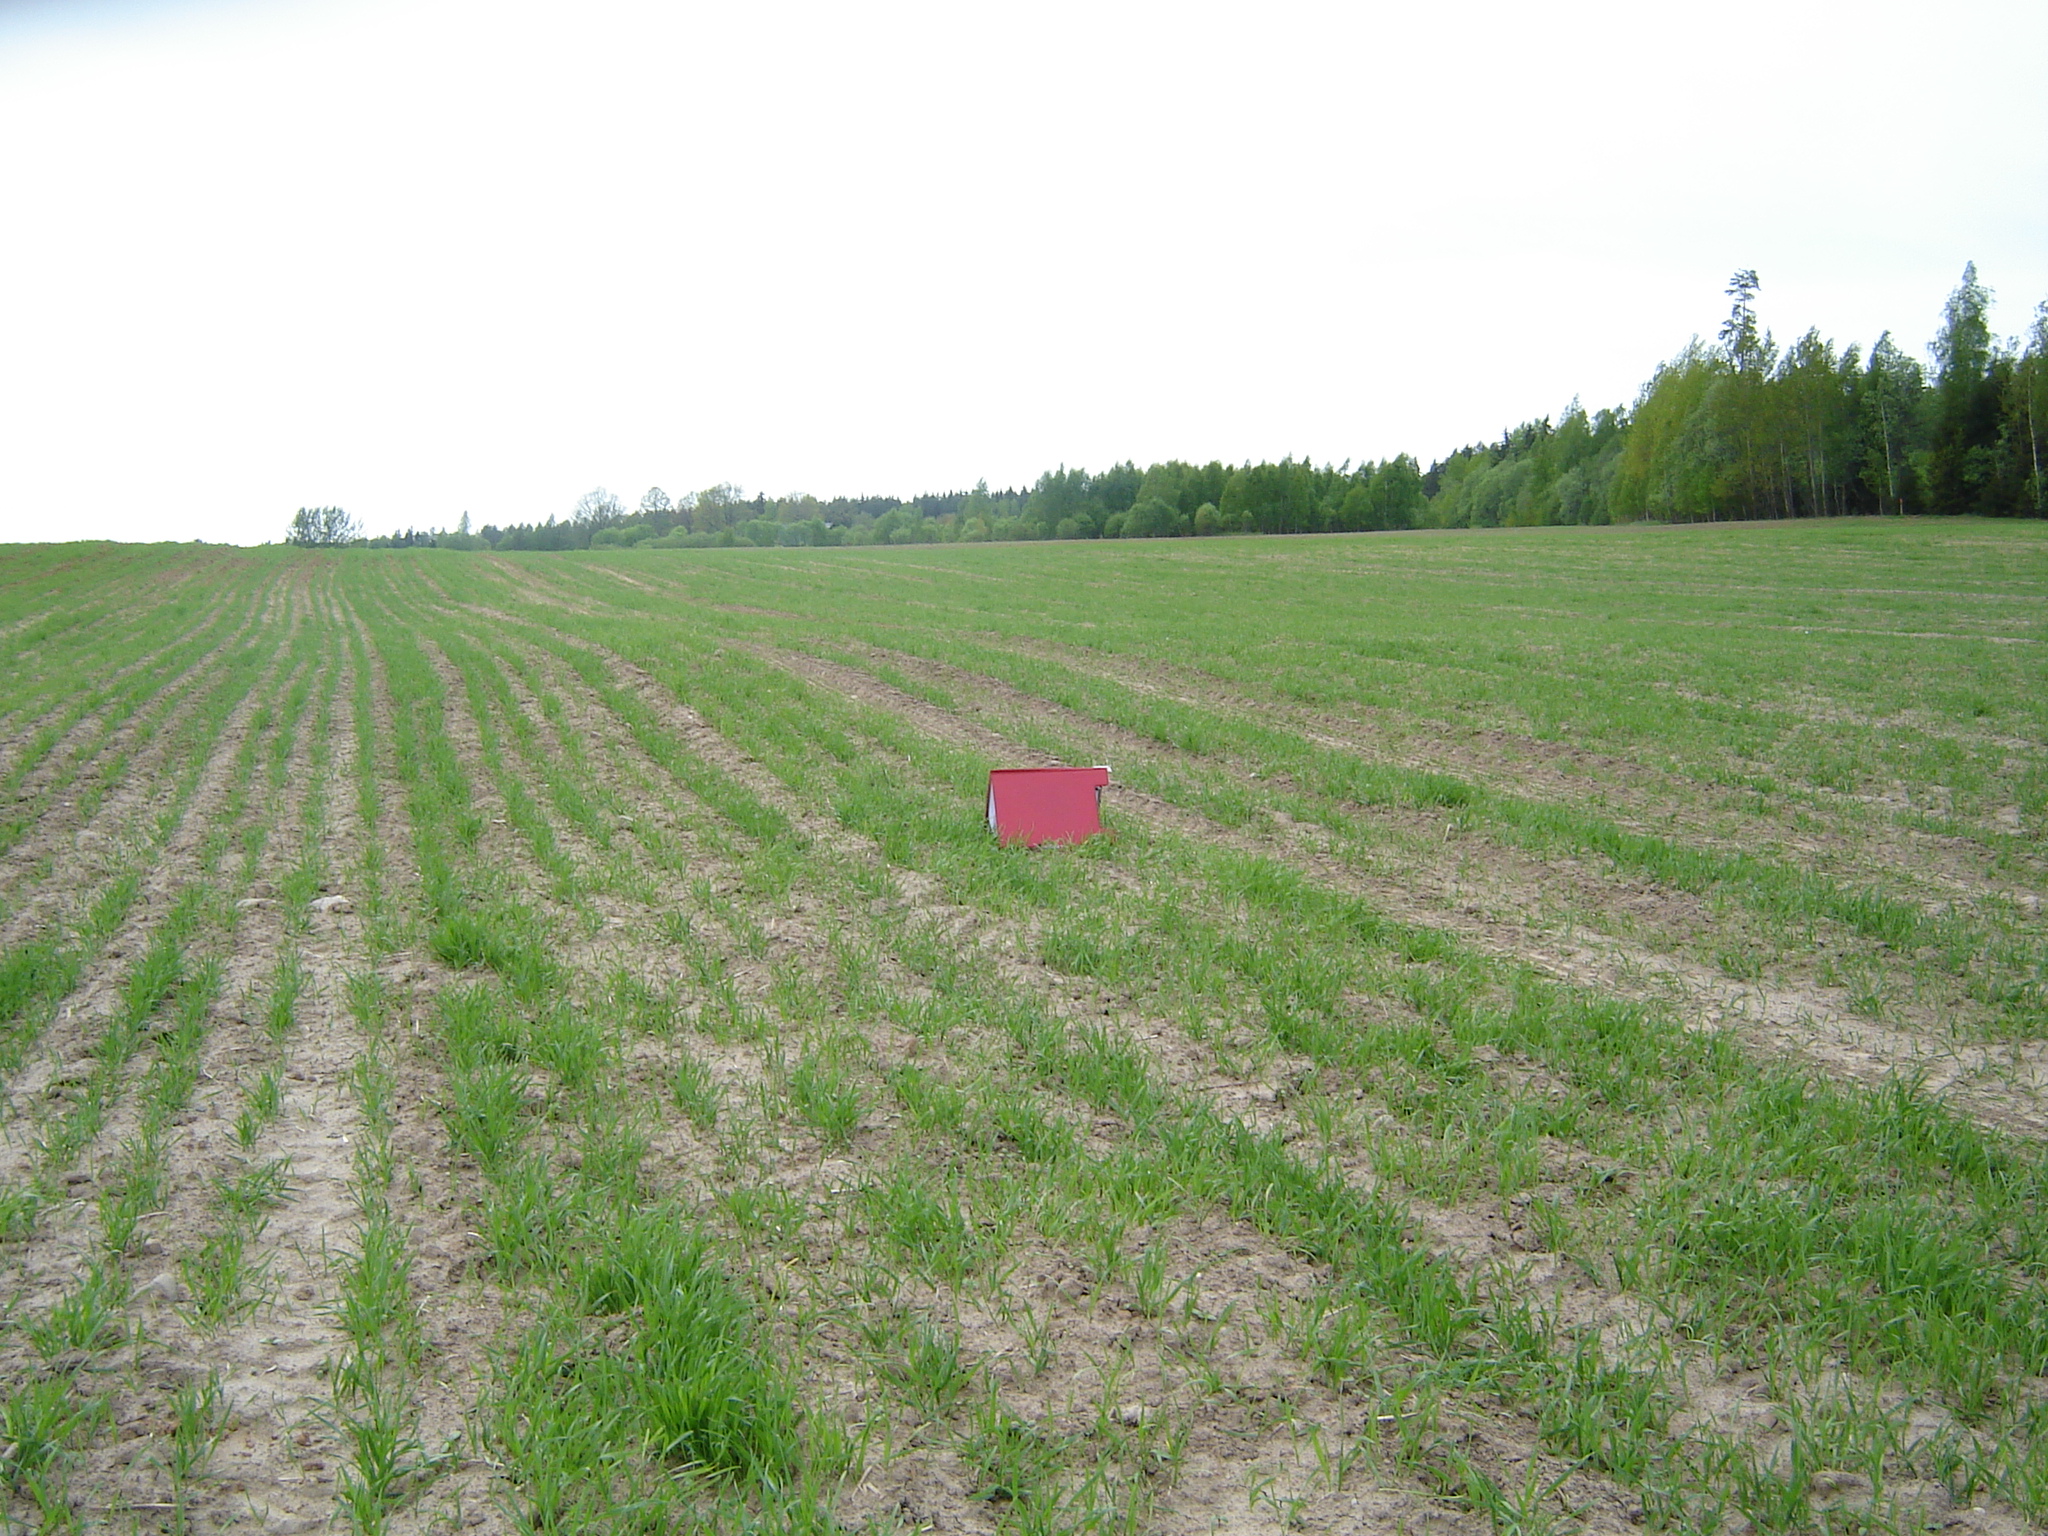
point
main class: Cropland
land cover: Common wheat
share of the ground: 25 - 50 %
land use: Agriculture (excluding fallow land and kitchen gardens)
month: May
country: LT
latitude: 55.8622
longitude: 25.6412
